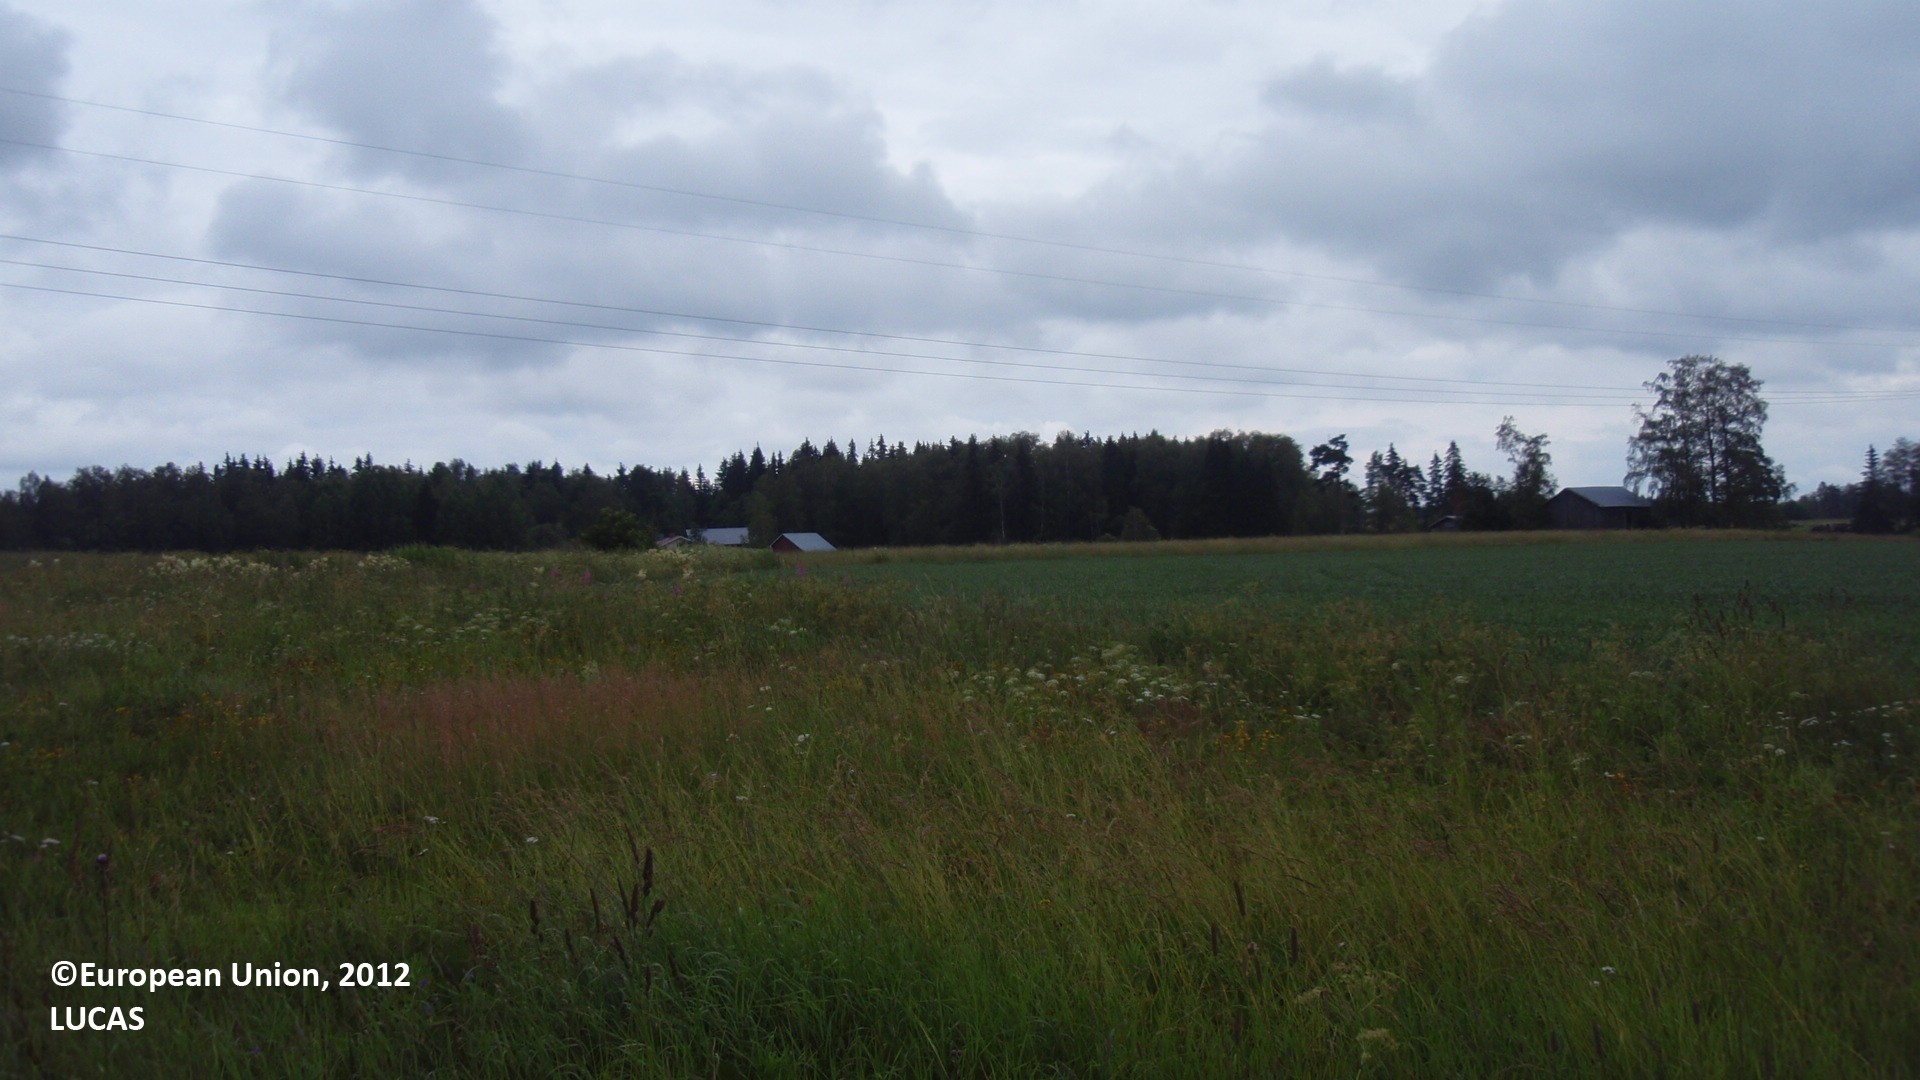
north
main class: Grassland
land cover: Grassland without tree/shrub cover
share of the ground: > 75 %
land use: Fallow land
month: July
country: FI
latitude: 61.0923
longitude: 28.5202
